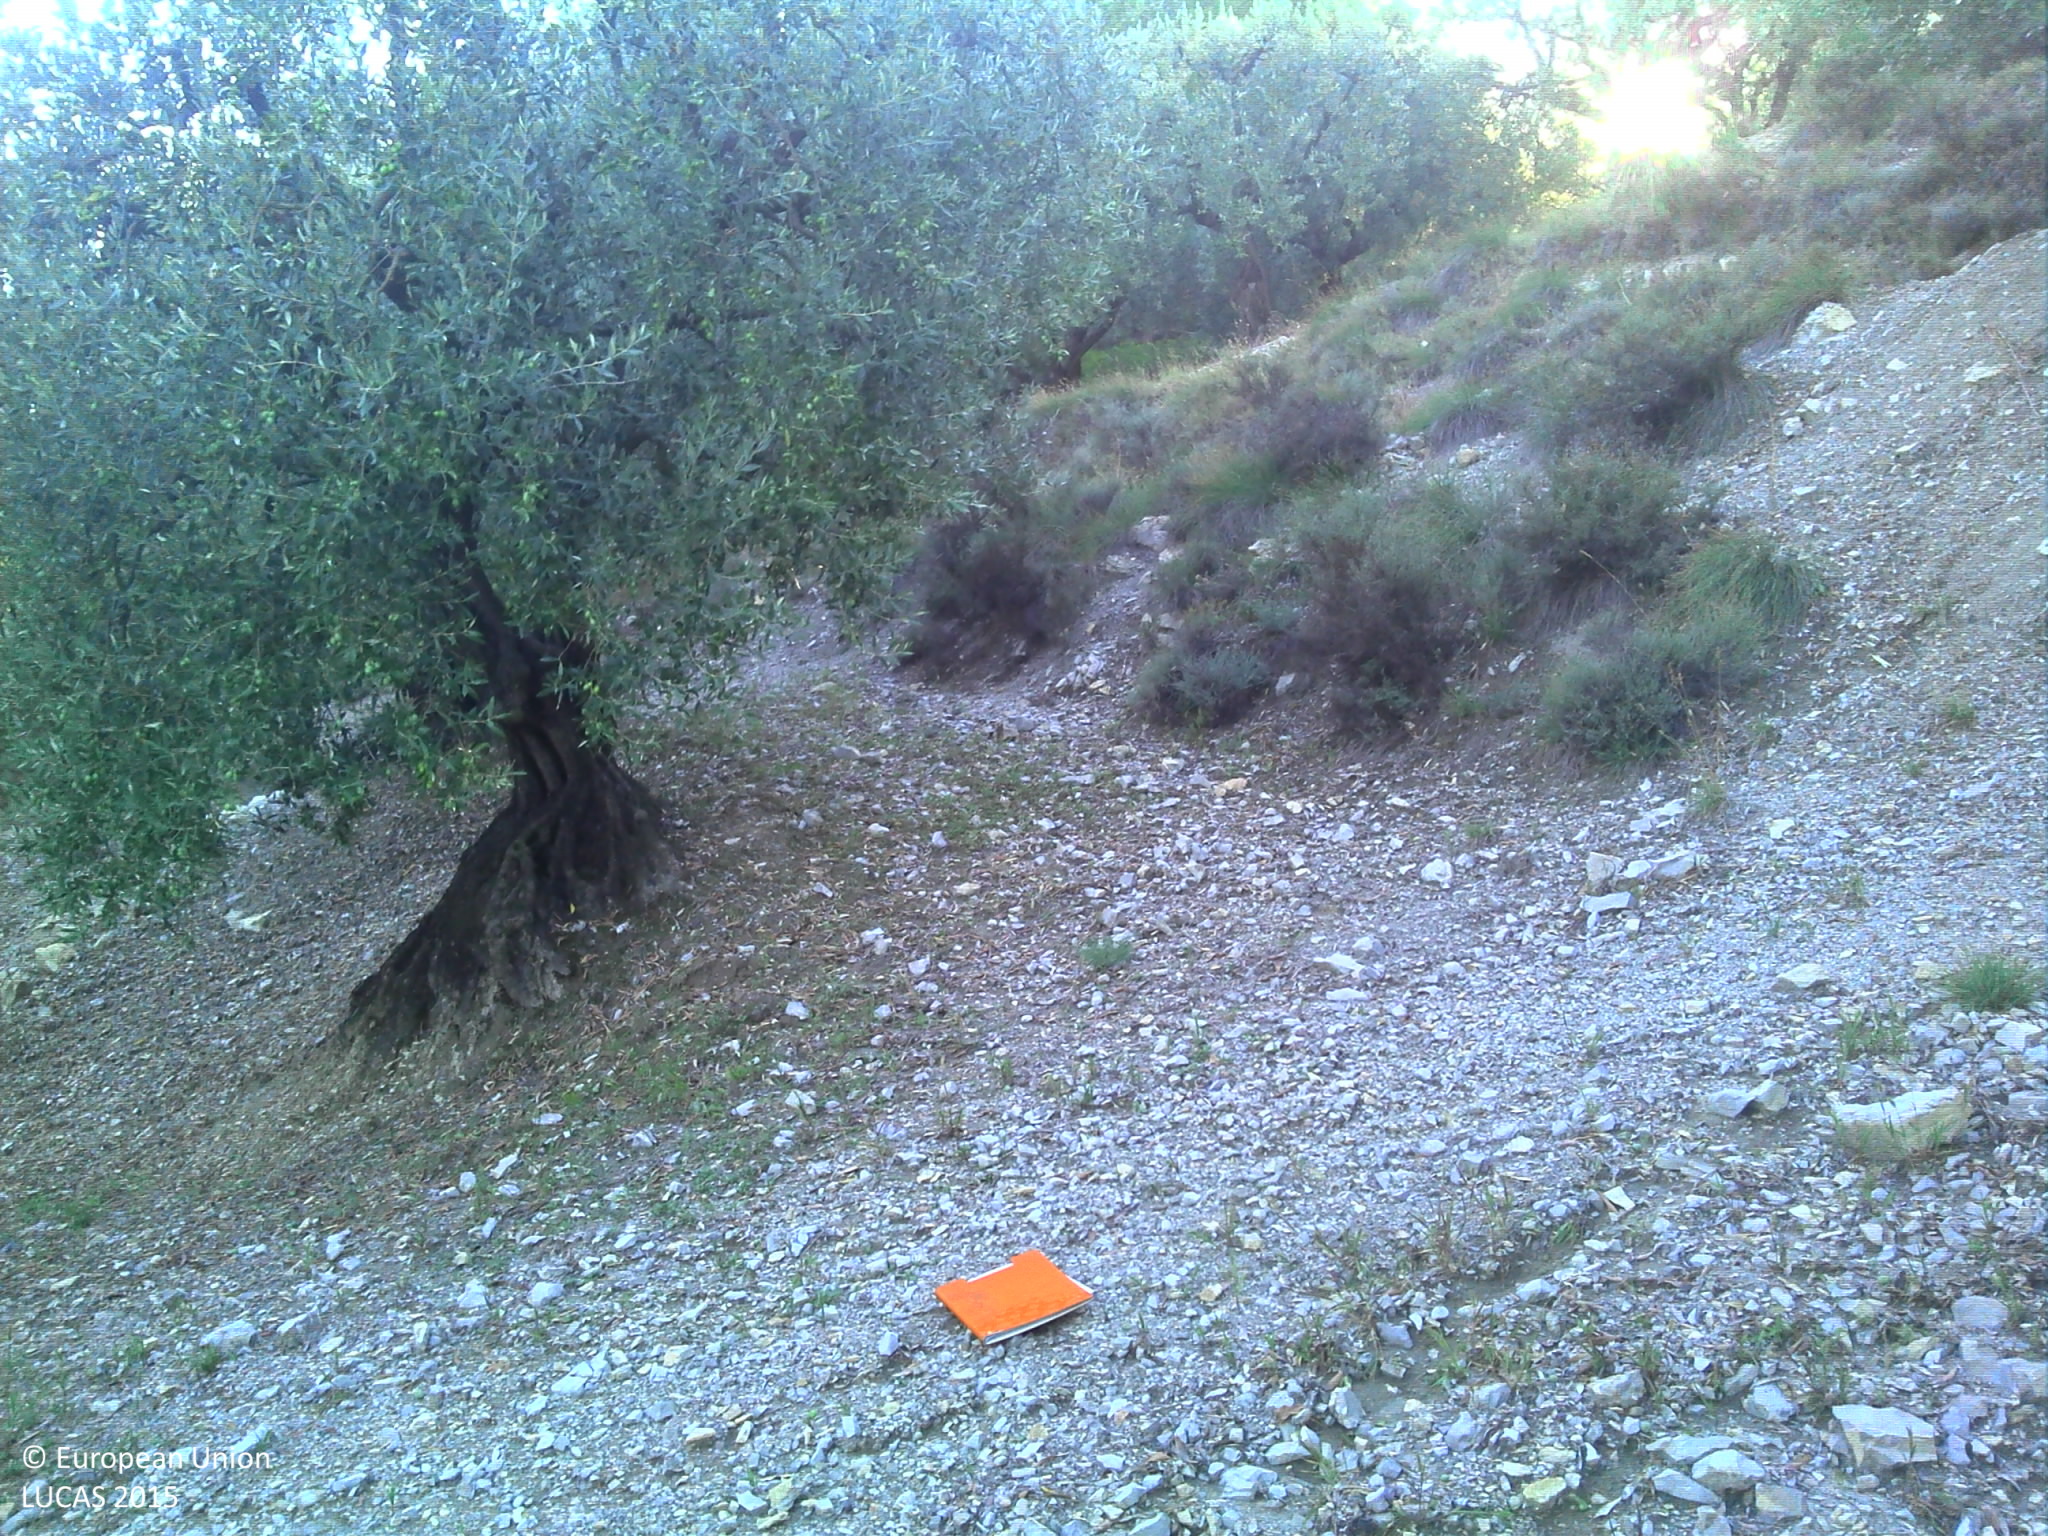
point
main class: Cropland
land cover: Olive groves
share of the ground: > 75 %
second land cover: Rocks and stones
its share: > 75 %
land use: Agriculture (excluding fallow land and kitchen gardens)
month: September
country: FR
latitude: 44.2975
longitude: 5.2824
